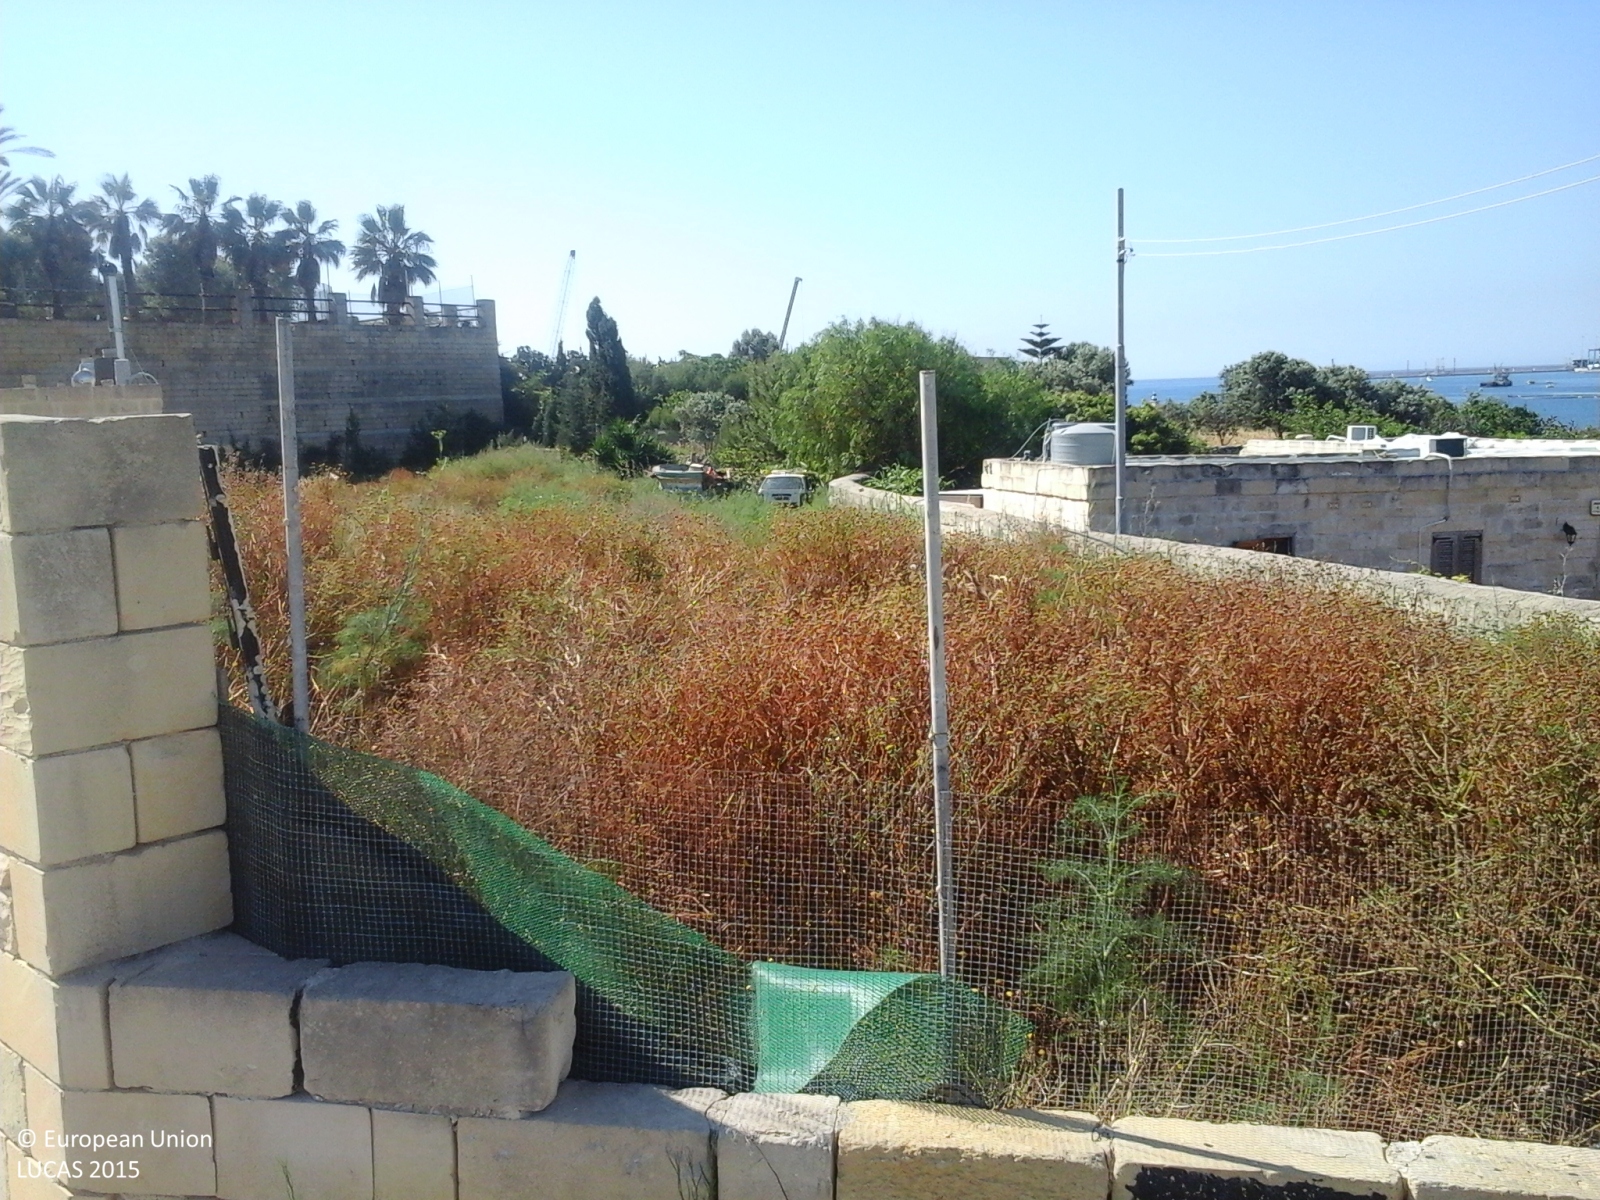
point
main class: Grassland
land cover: Grassland without tree/shrub cover
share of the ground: > 75 %
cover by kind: herbaceous plants 60 %, shrubs 5 %
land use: Abandoned areas
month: May
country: MT
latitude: 35.8368
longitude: 14.5521
